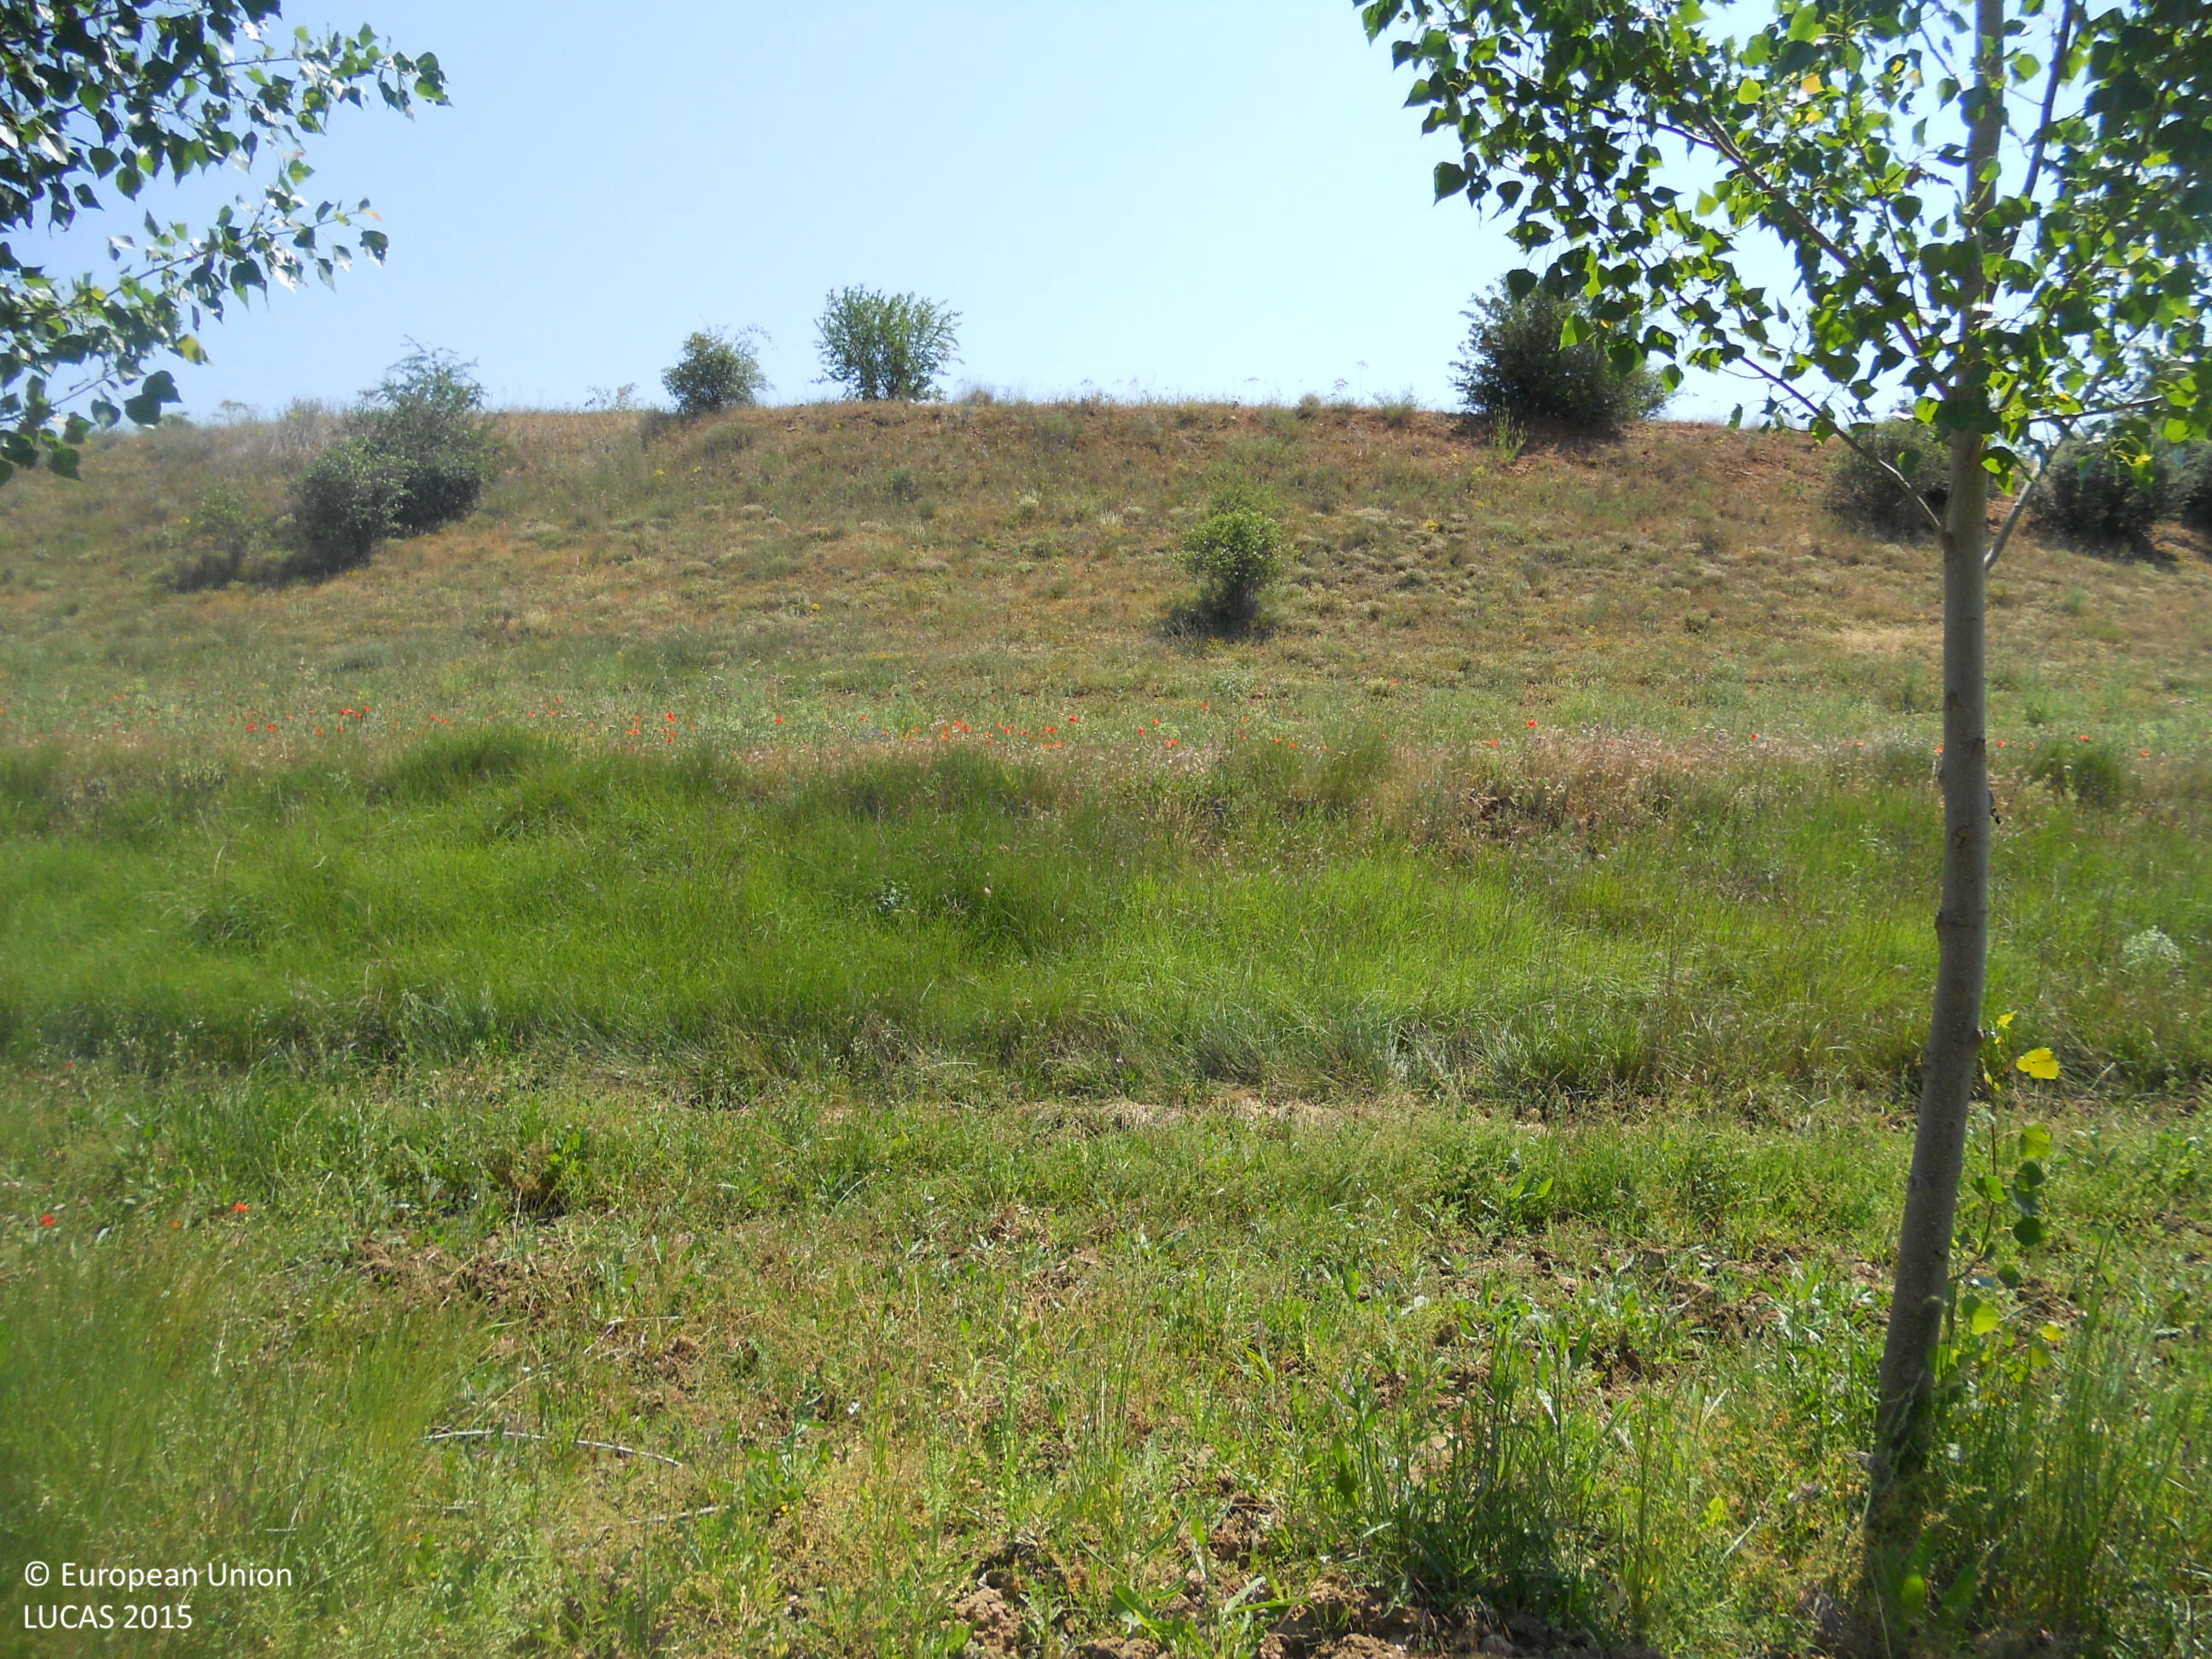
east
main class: Woodland
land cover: Broadleaved woodland
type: exotic forest
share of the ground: 10 - 25 %
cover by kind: herbaceous plants 75 %, broadleaved forest trees 20 %, shrubs 5 %
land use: Forestry
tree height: < 5 m
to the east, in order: Broadleaved woodland; Grassland with sparse tree/shrub cover; Grassland without tree/shrub cover; Rivers and streams; Grassland with sparse tree/shrub cover
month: June
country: ES
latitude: 42.1977
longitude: -5.3096
